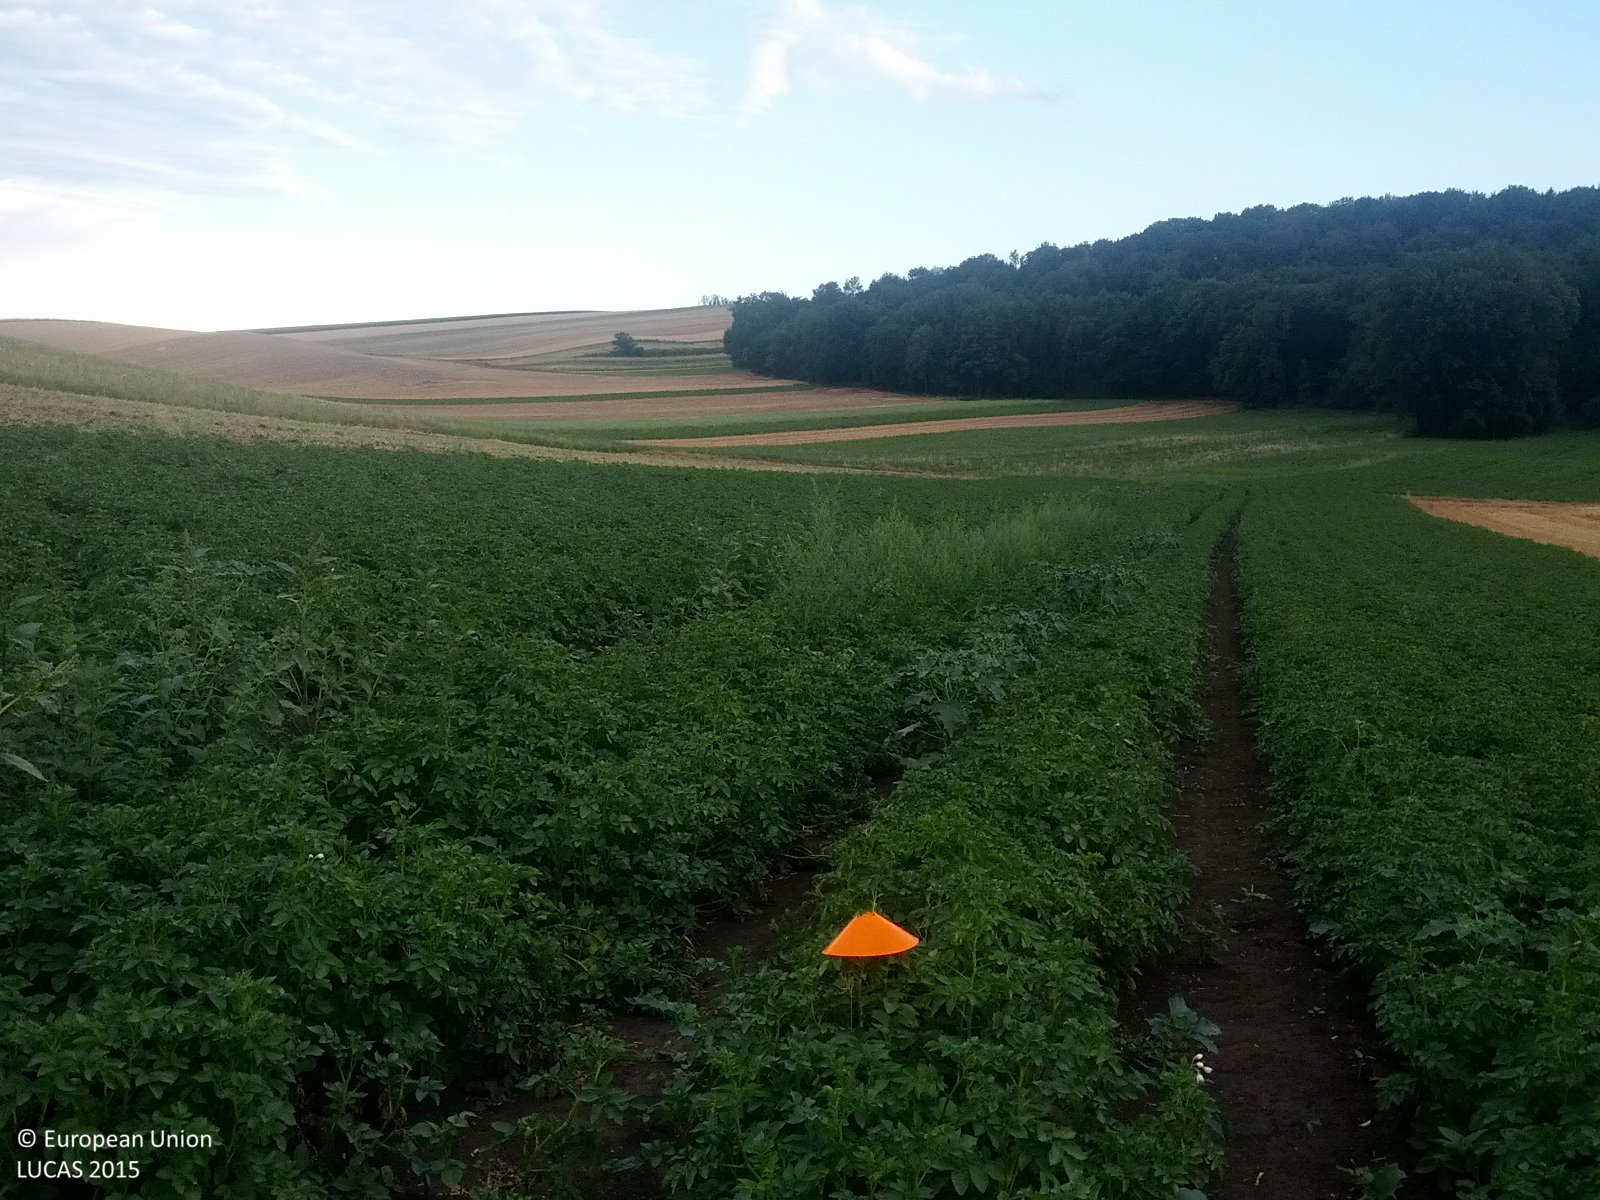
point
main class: Cropland
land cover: Potatoes
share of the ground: > 75 %
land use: Agriculture (excluding fallow land and kitchen gardens)
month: July
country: AT
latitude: 48.4931
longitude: 16.3247
